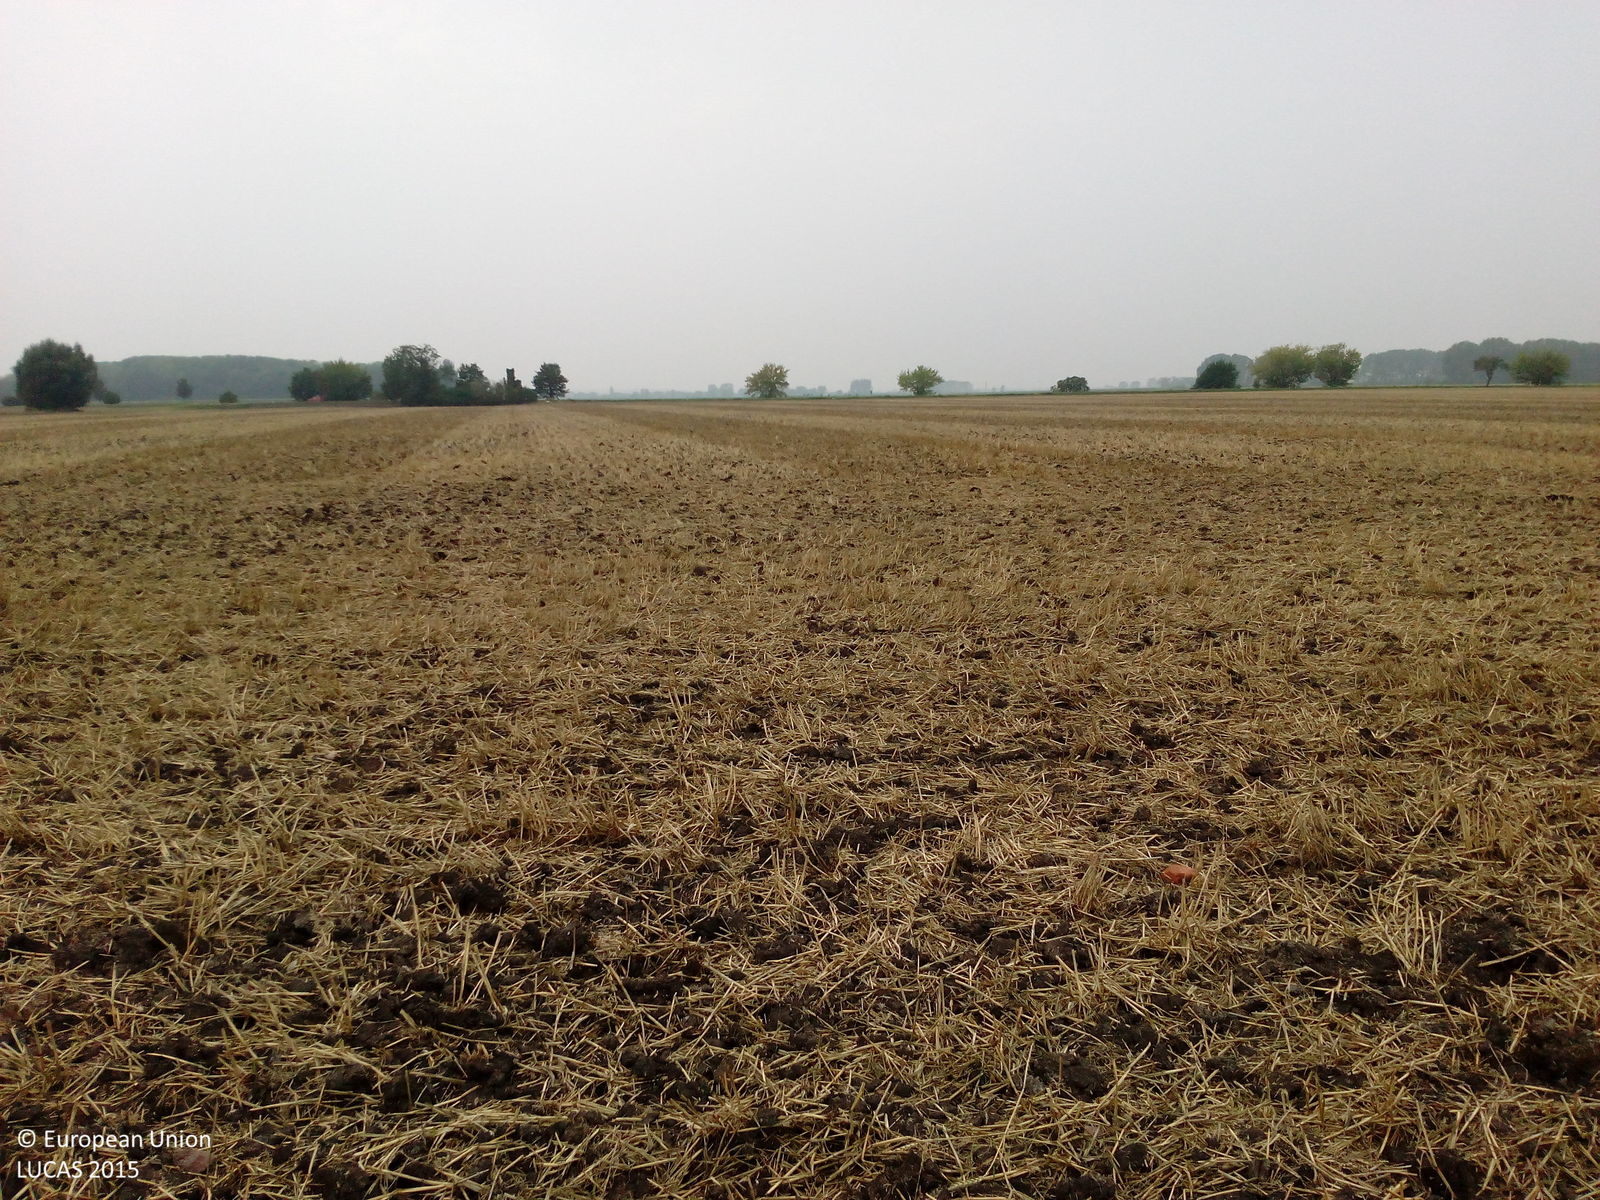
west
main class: Cropland
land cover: Common wheat
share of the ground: 50 - 75 %
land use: Agriculture (excluding fallow land and kitchen gardens)
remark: Harvested field
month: August
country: DE
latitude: 51.0608
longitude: 11.0128
